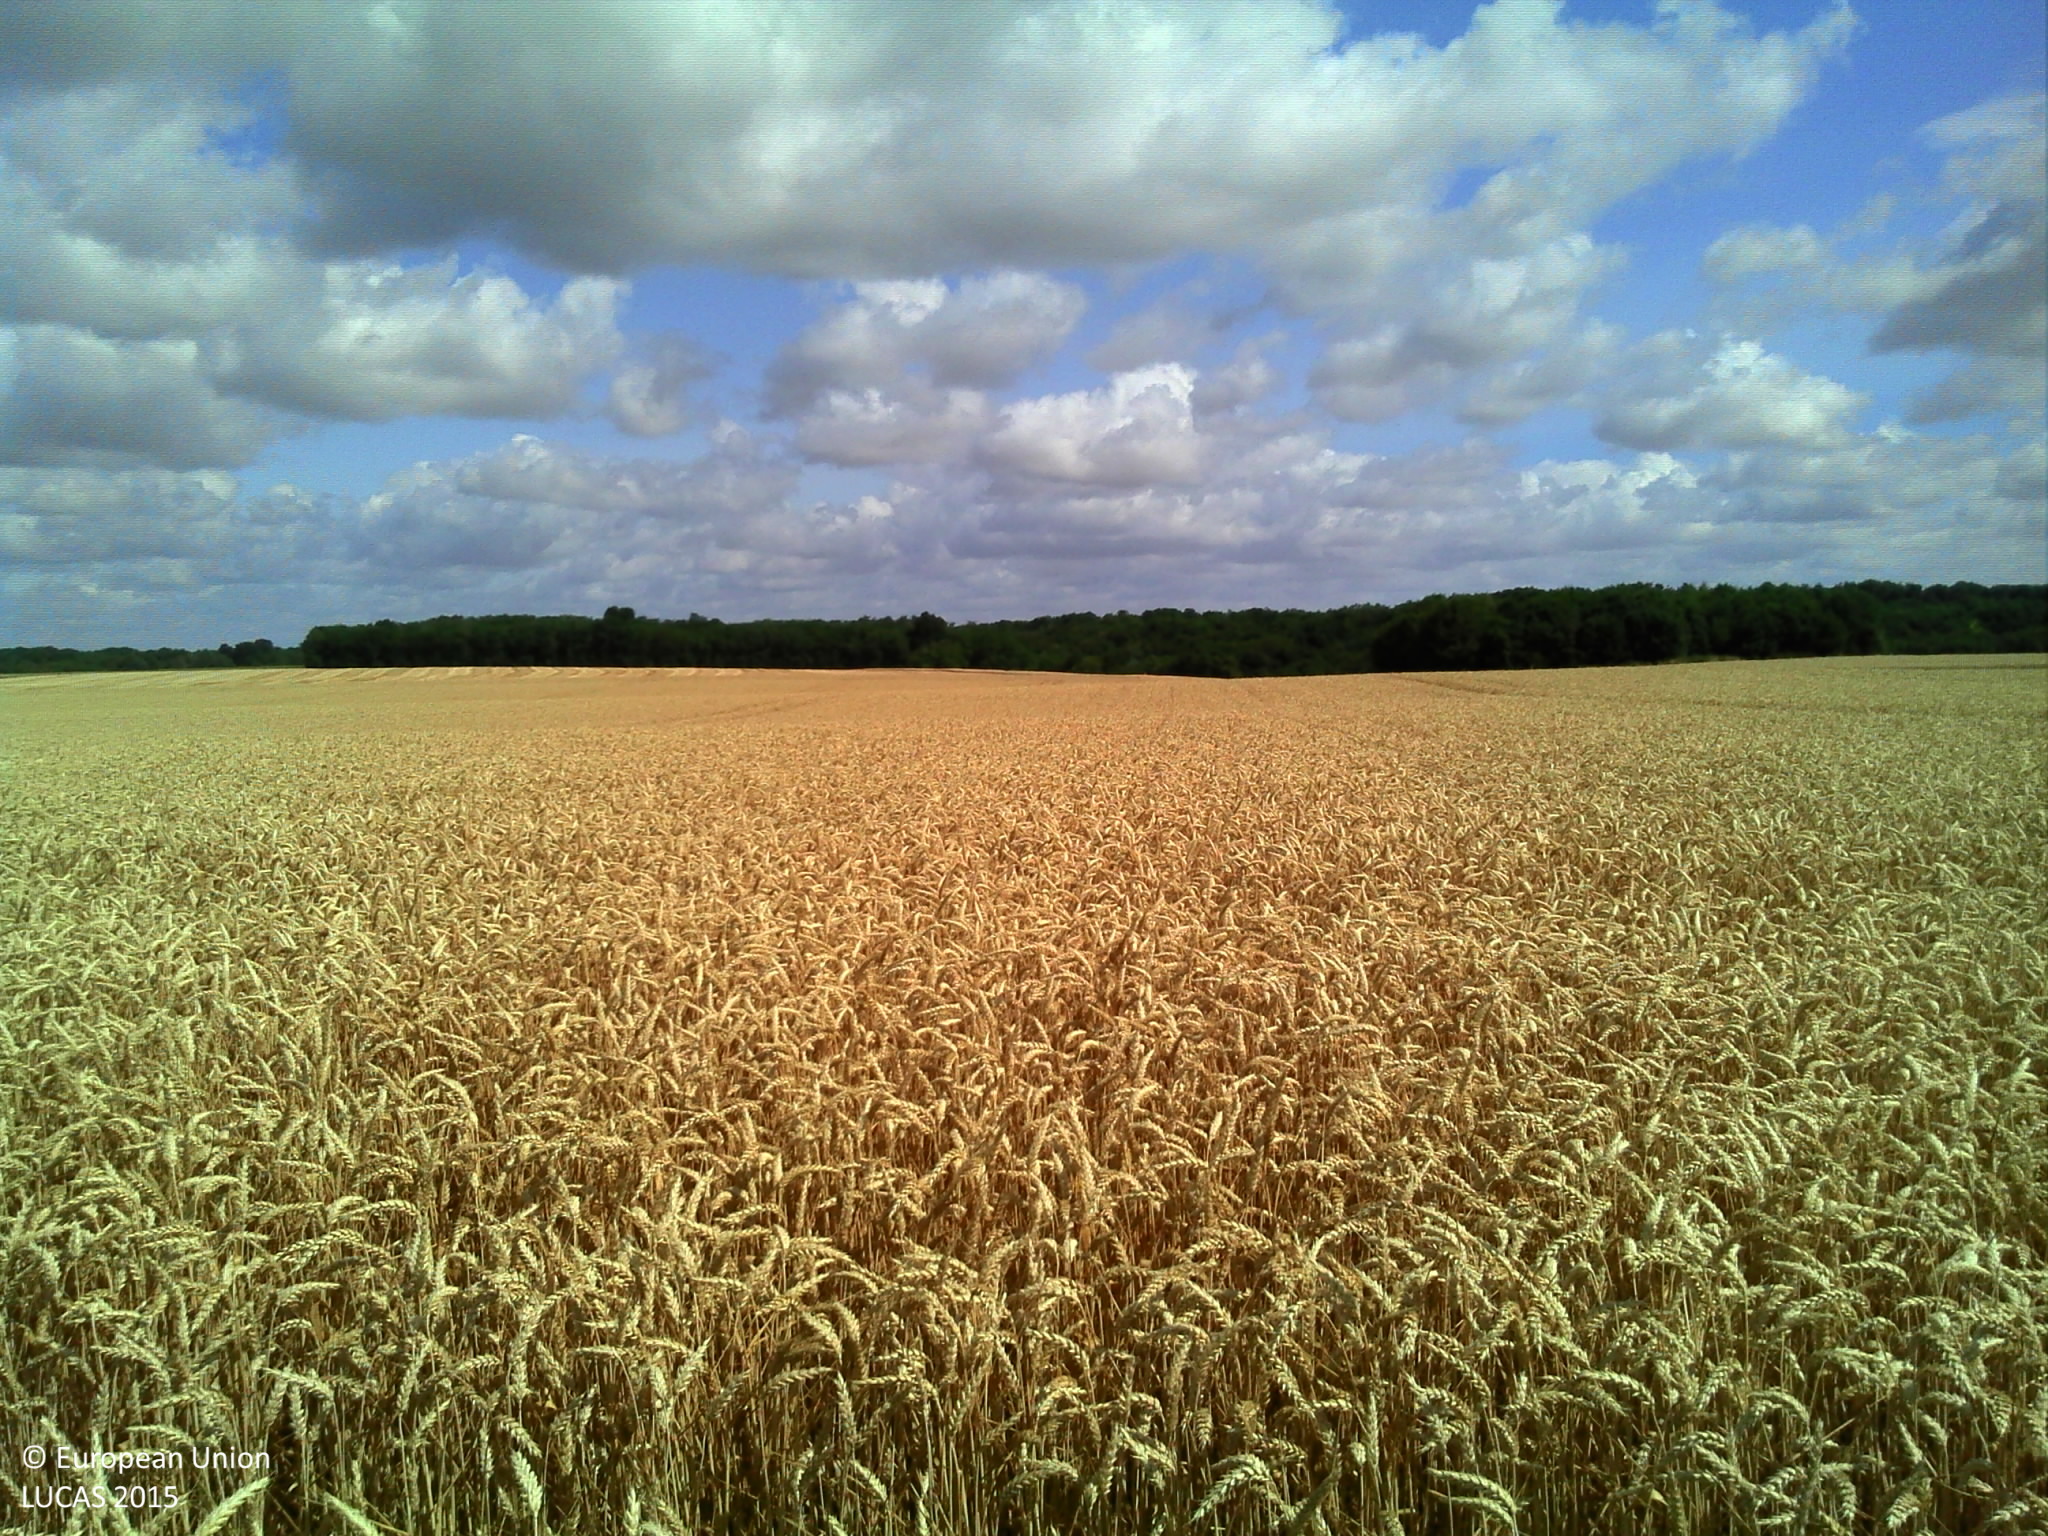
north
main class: Cropland
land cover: Common wheat
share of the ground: > 75 %
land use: Agriculture (excluding fallow land and kitchen gardens)
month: July
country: FR
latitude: 48.0969
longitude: 2.8080
